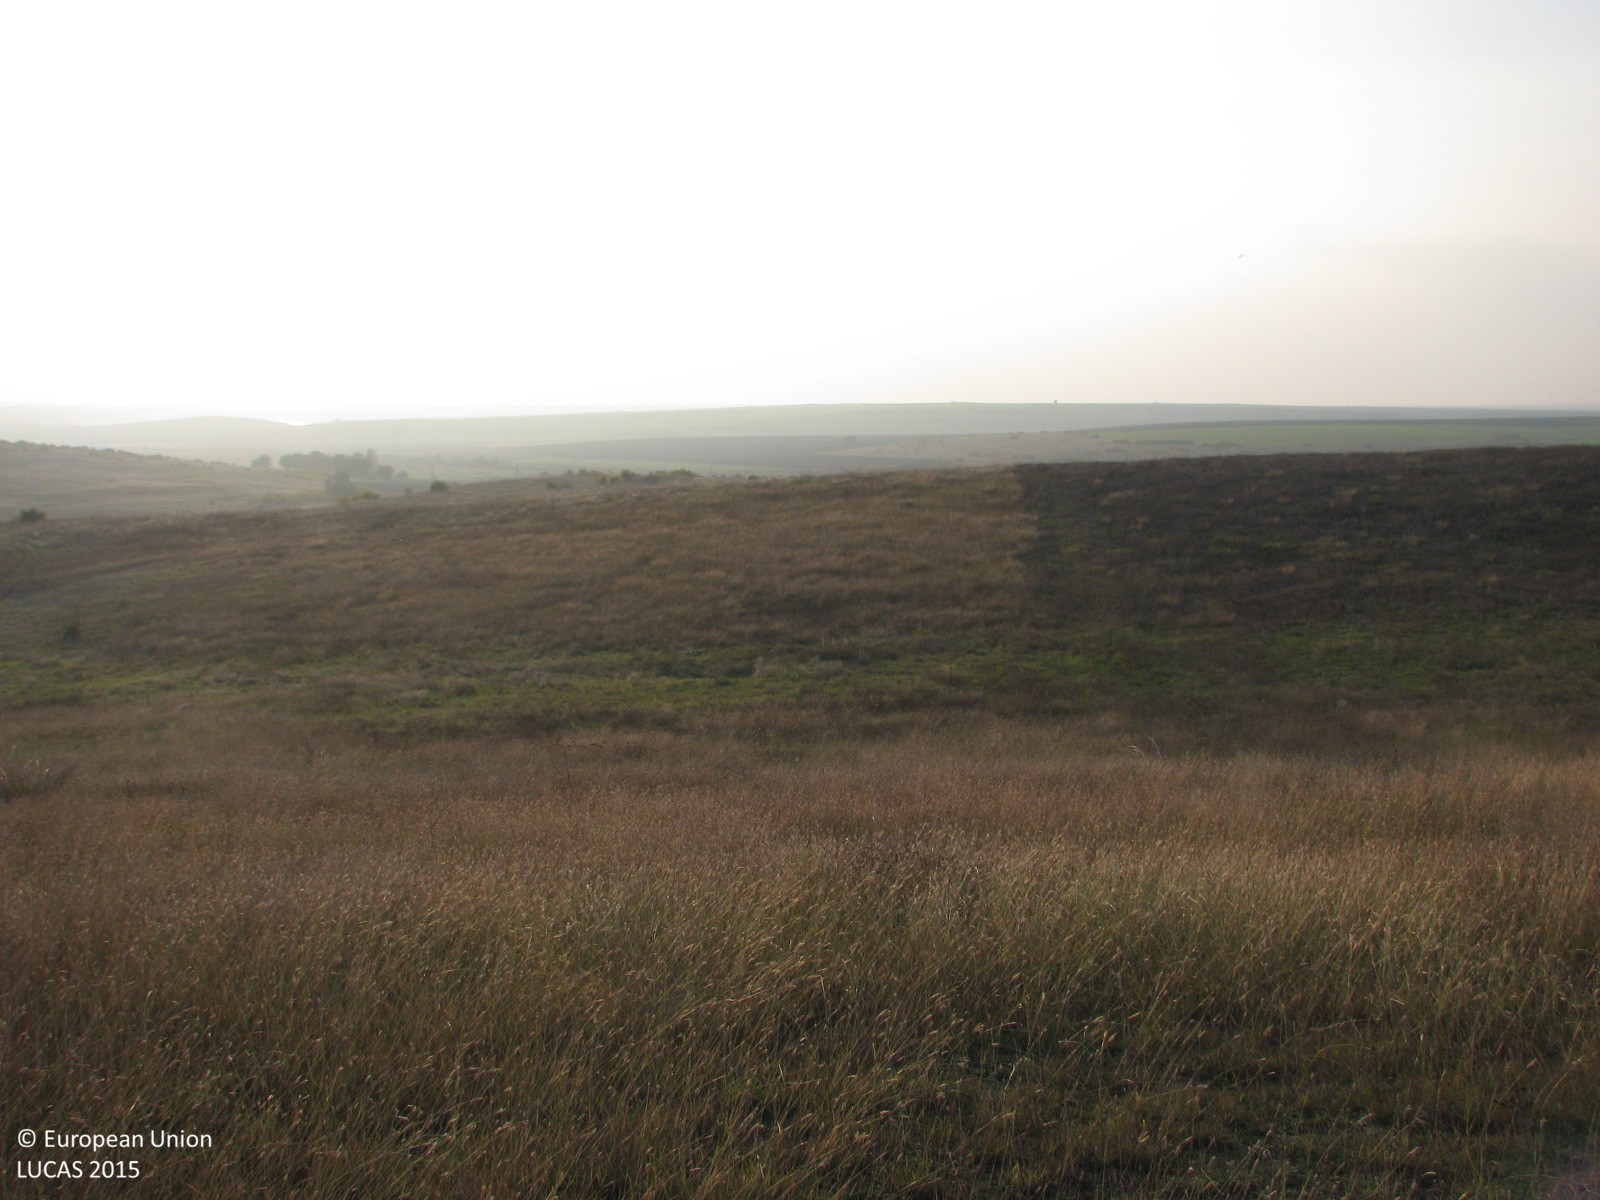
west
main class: Grassland
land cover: Grassland without tree/shrub cover
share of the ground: > 75 %
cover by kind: herbaceous plants 100 %
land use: Agriculture (excluding fallow land and kitchen gardens)
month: October
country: BG
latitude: 42.2954
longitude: 26.4257
